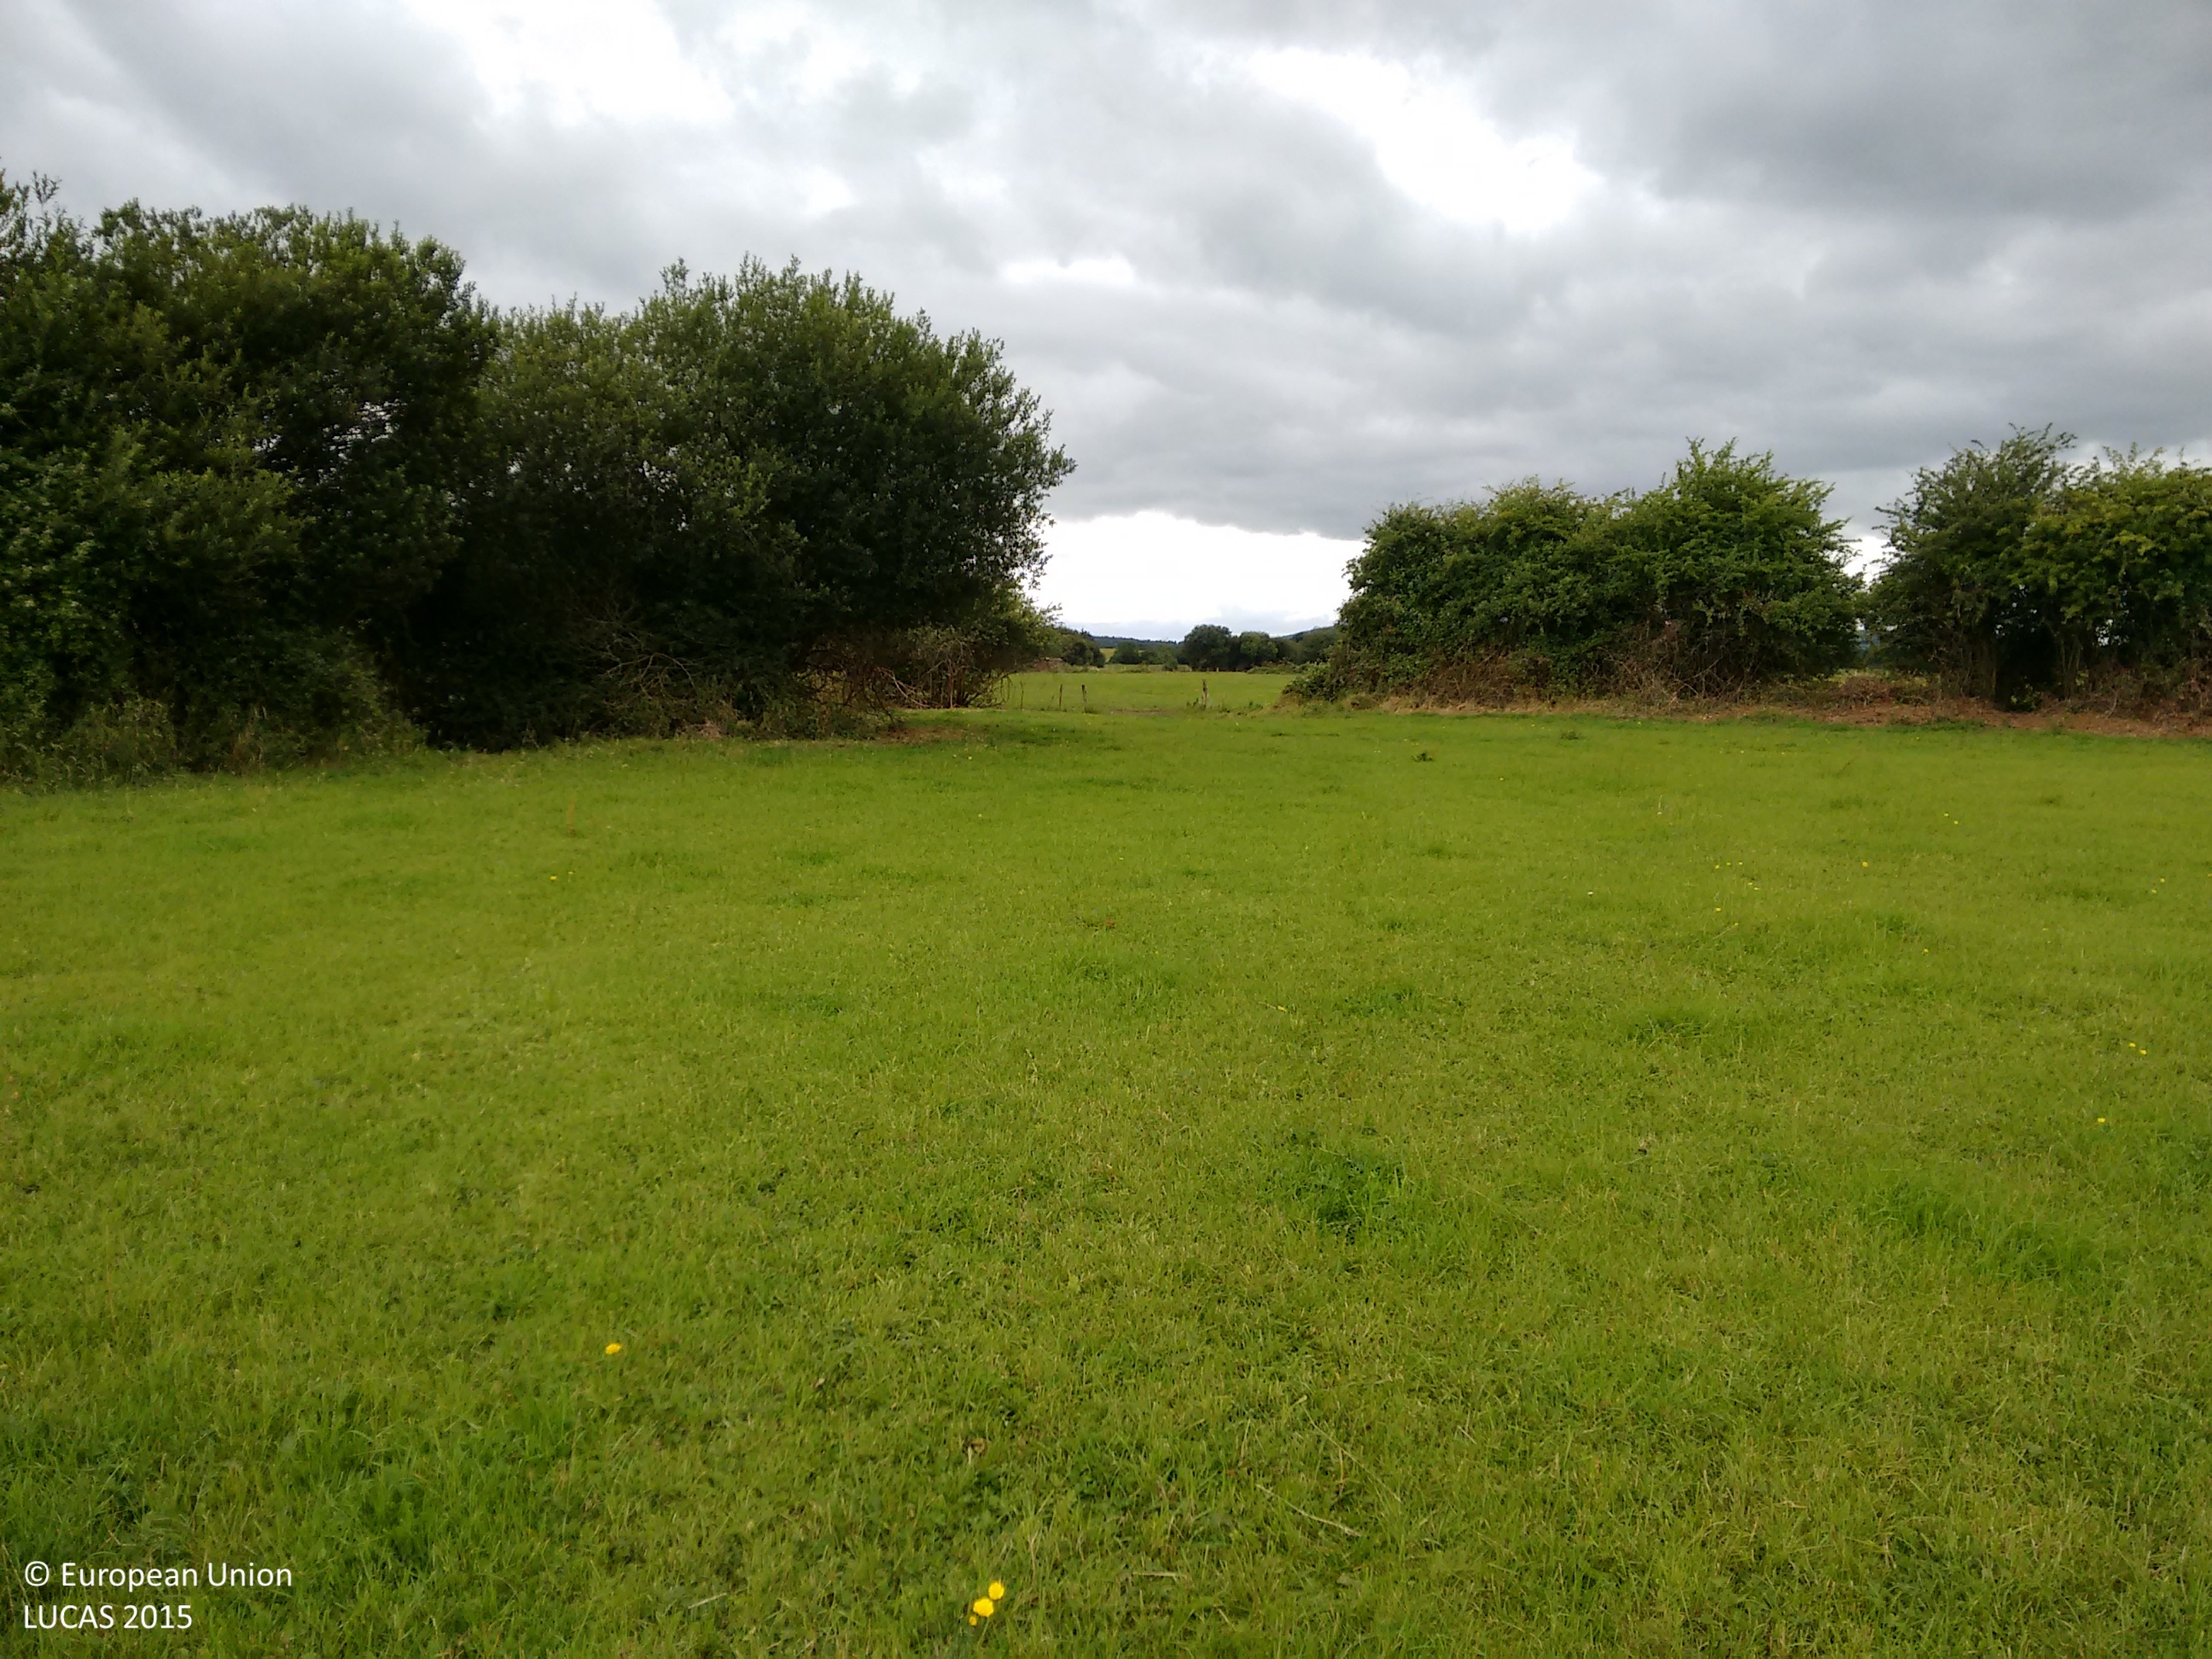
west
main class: Grassland
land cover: Grassland without tree/shrub cover
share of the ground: > 75 %
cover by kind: herbaceous plants 100 %
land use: Agriculture (excluding fallow land and kitchen gardens)
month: July
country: IE
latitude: 52.7253
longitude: -7.3443
